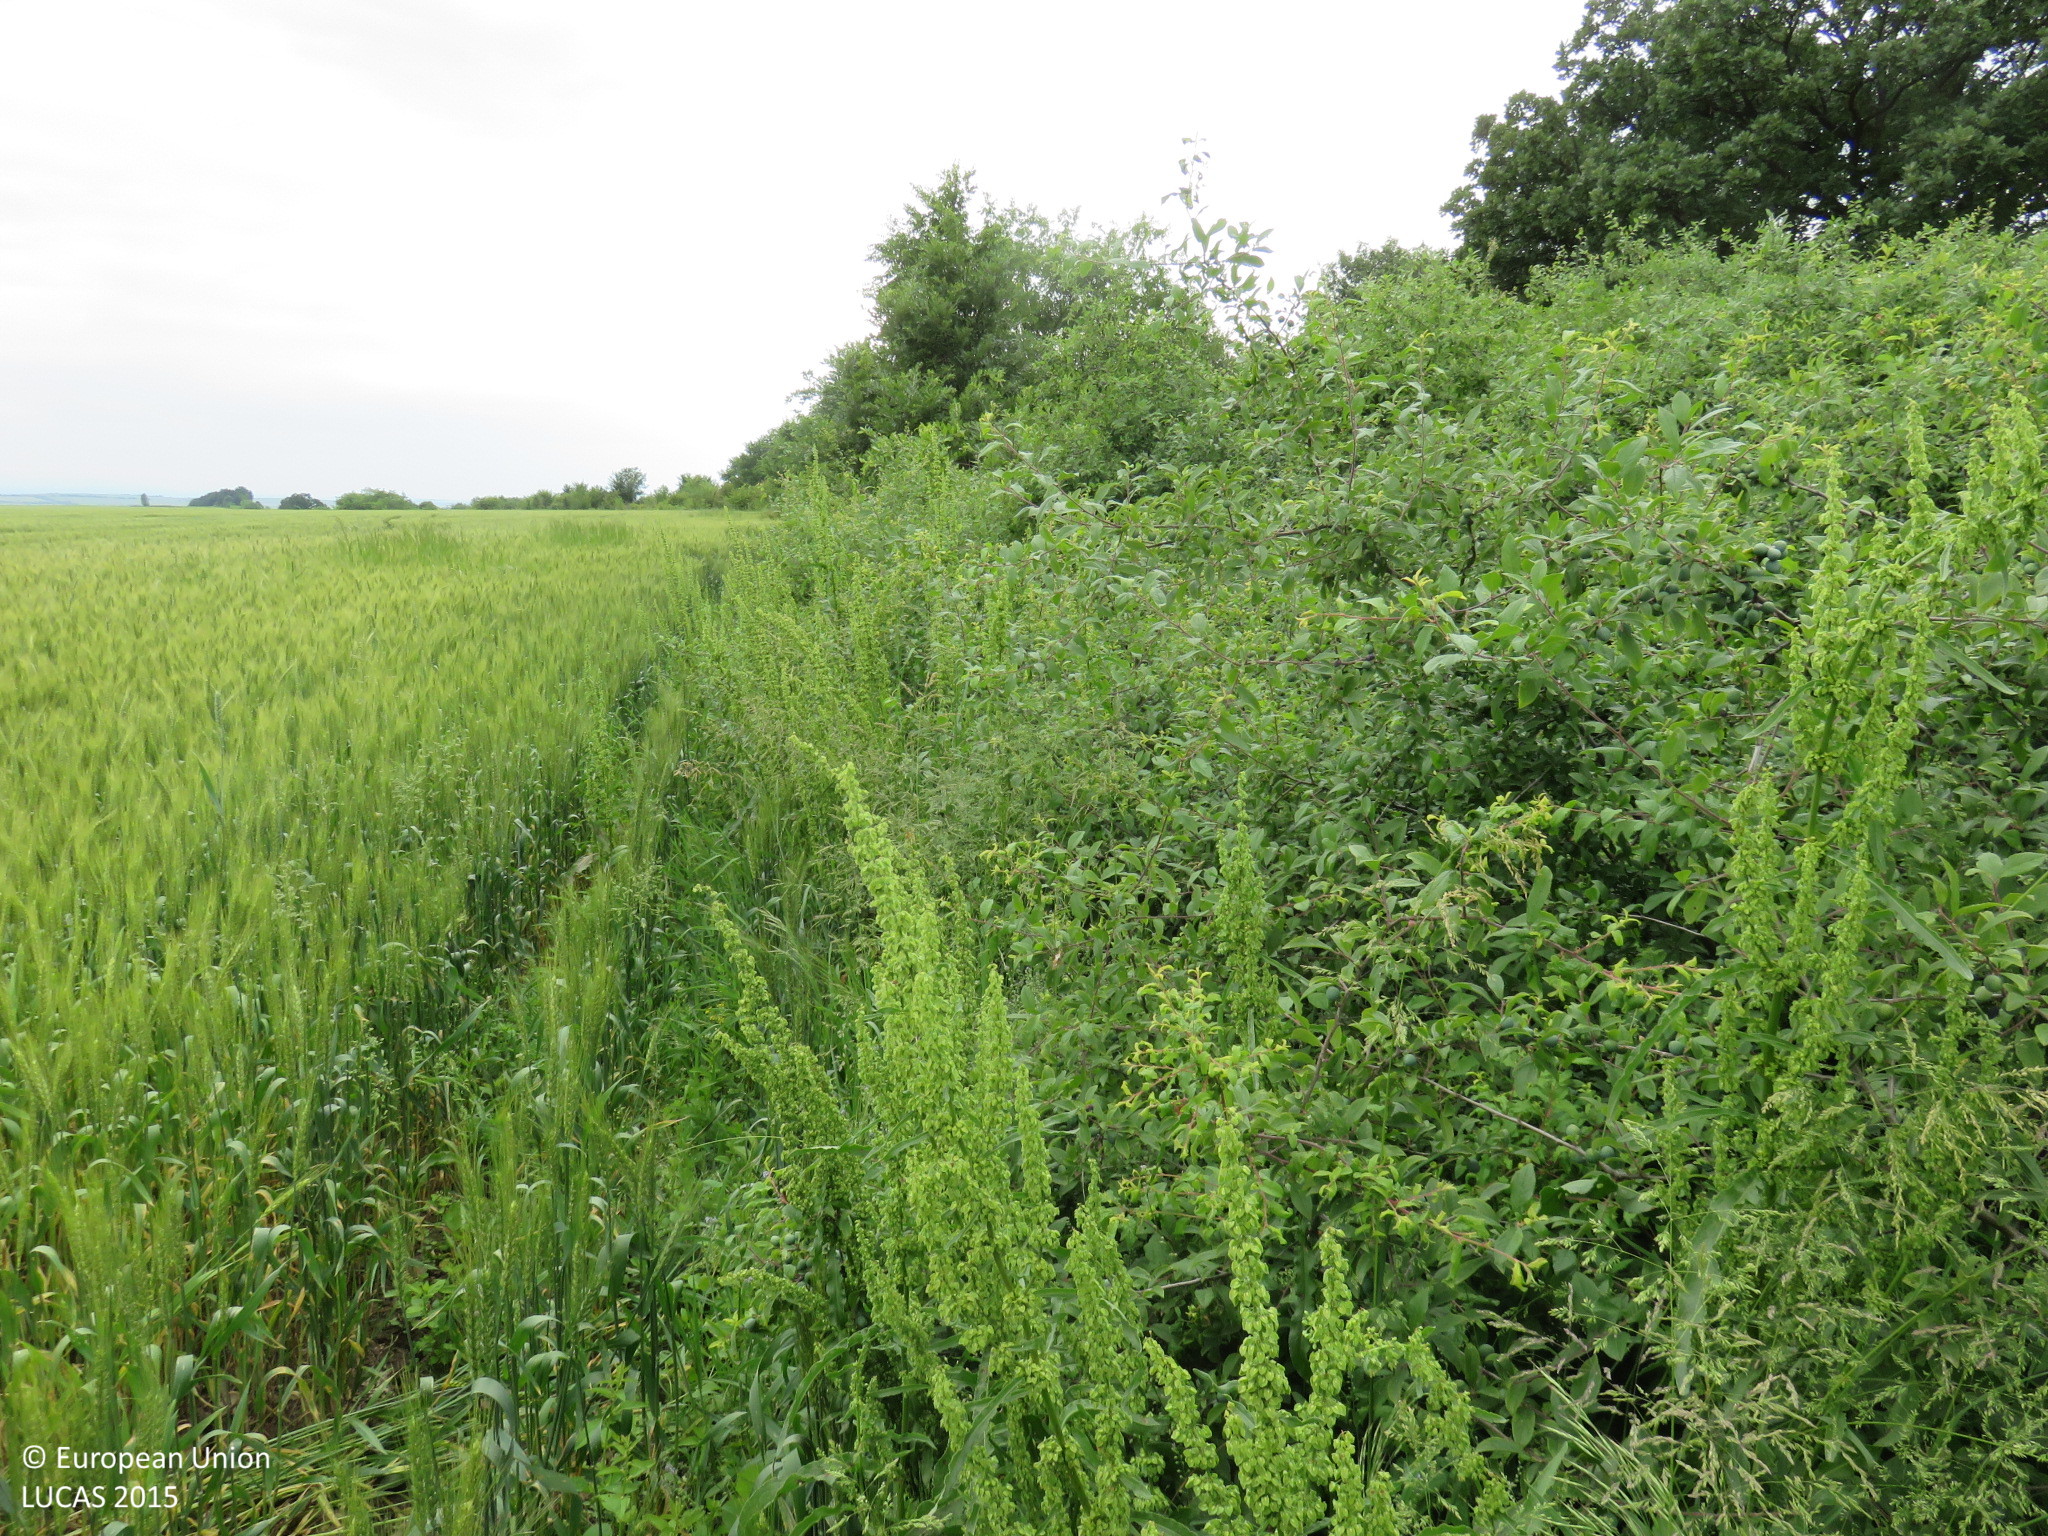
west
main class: Shrubland
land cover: Shrubland without tree cover
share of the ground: > 75 %
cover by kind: shrubs 100 %
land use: Semi-natural and natural areas not in use
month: May
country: BG
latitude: 43.2408
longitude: 24.4543
